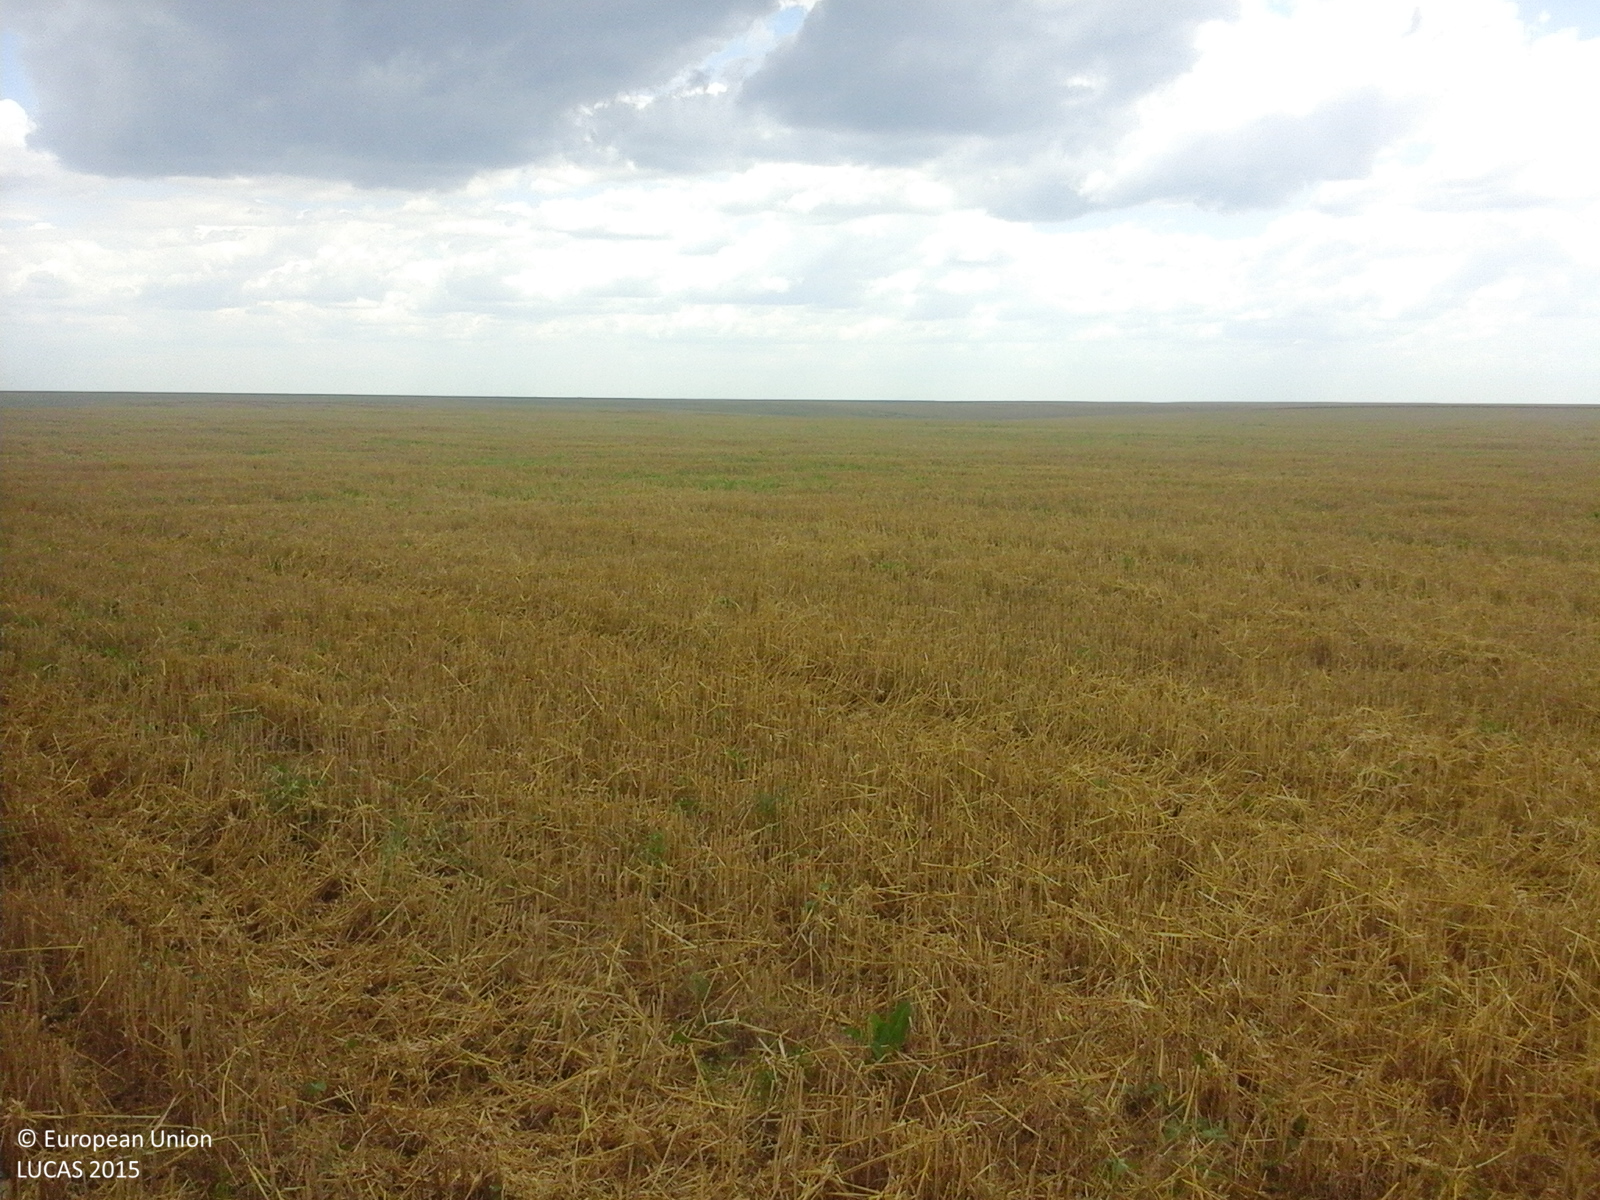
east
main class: Cropland
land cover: Common wheat
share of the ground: < 10 %
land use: Agriculture (excluding fallow land and kitchen gardens)
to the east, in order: Common wheat
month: July
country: RO
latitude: 43.8753
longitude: 25.2505
